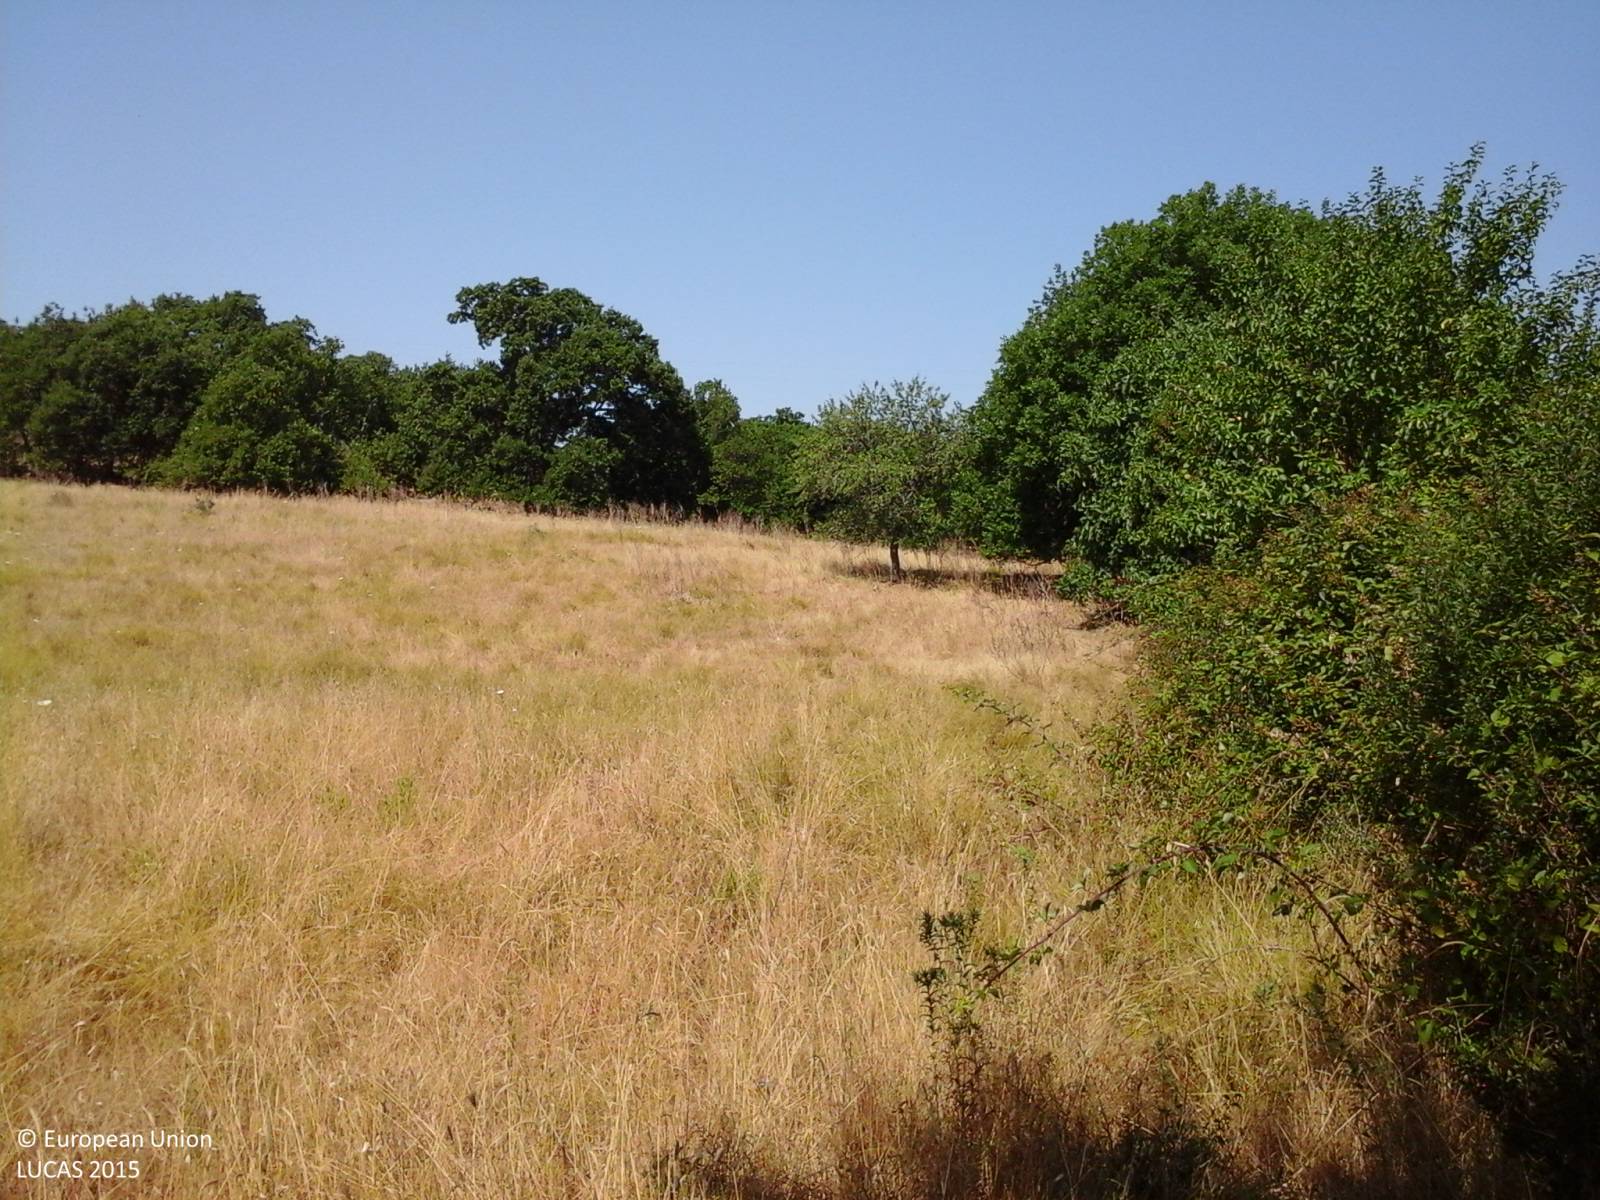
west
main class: Woodland
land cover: Broadleaved woodland
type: thermophilous deciduous forest
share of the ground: 25 - 50 %
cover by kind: broadleaved forest trees 90 %, herbaceous plants 10 %
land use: Semi-natural and natural areas not in use
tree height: > 5 m
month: July
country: IT
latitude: 40.7850
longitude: 8.8088
